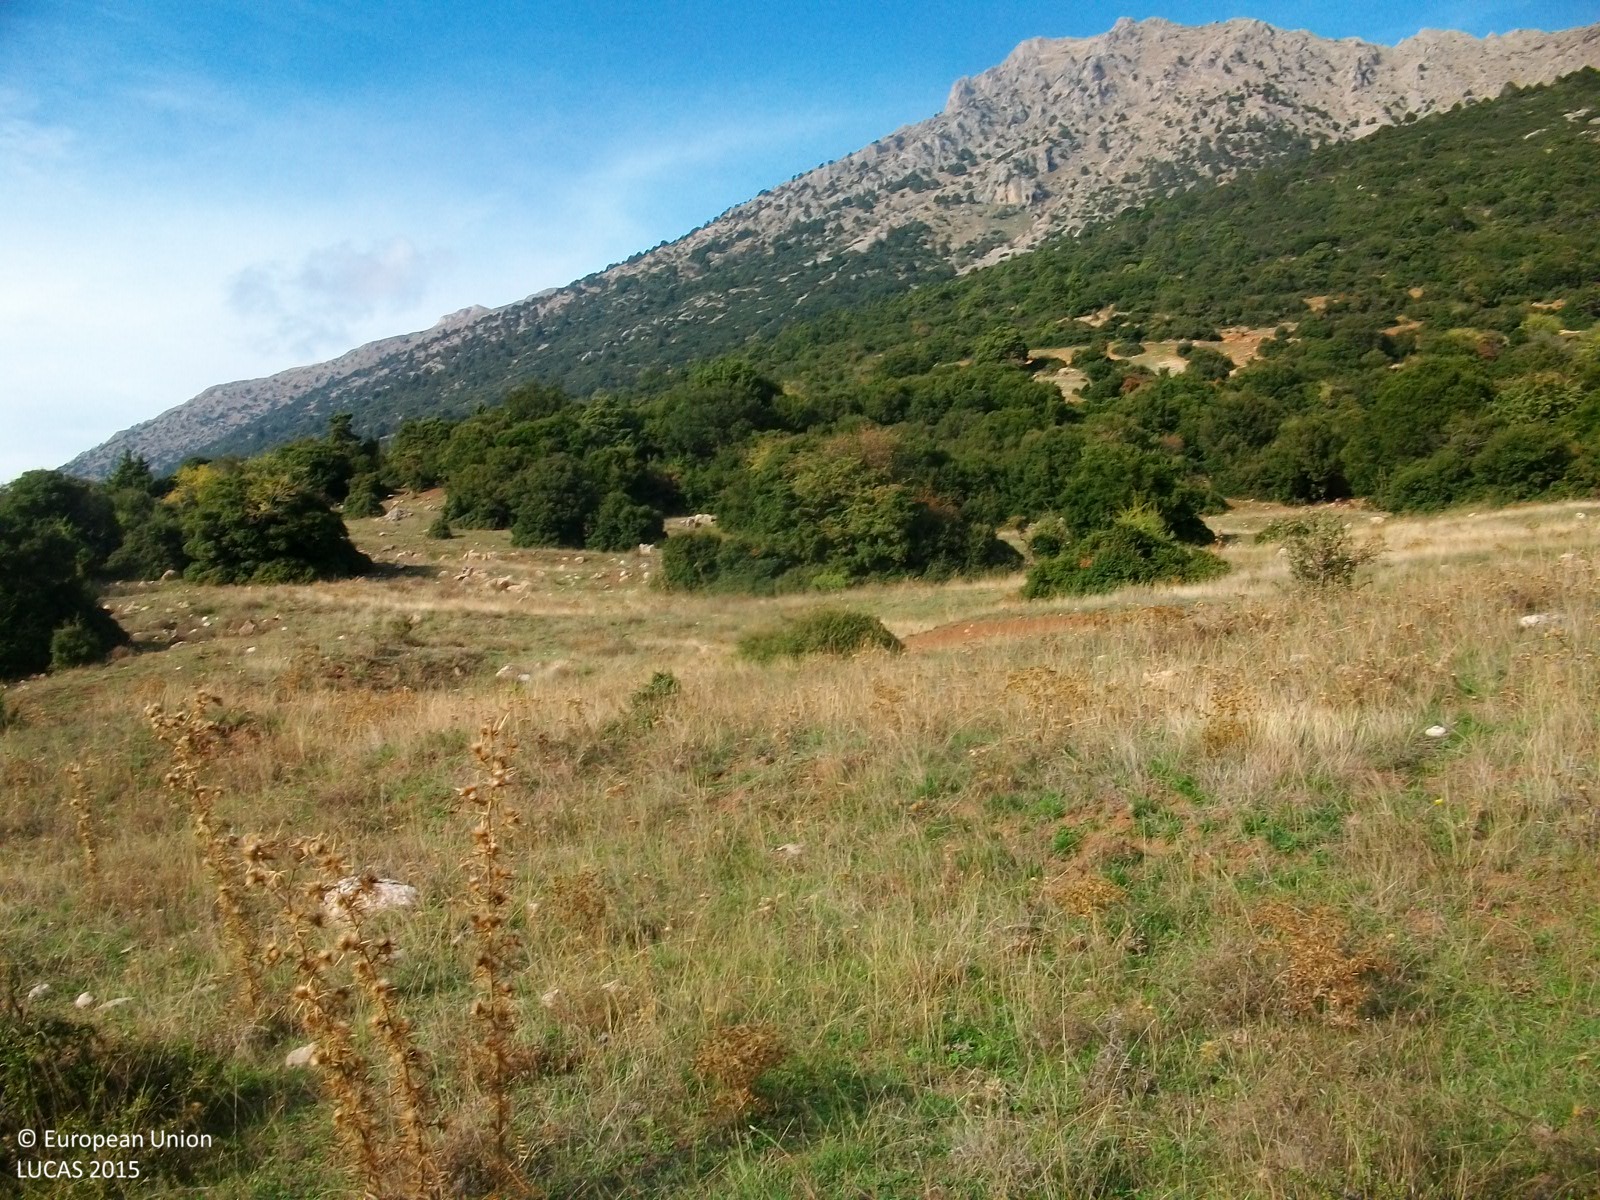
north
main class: Grassland
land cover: Grassland with sparse tree/shrub cover
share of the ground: > 75 %
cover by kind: herbaceous plants 80 %, unconsolidated bare surface 10 %, coniferous forest trees 5 %, shrubs 5 %
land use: Semi-natural and natural areas not in use
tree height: < 5 m
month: October
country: GR
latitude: 37.8860
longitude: 22.3950
